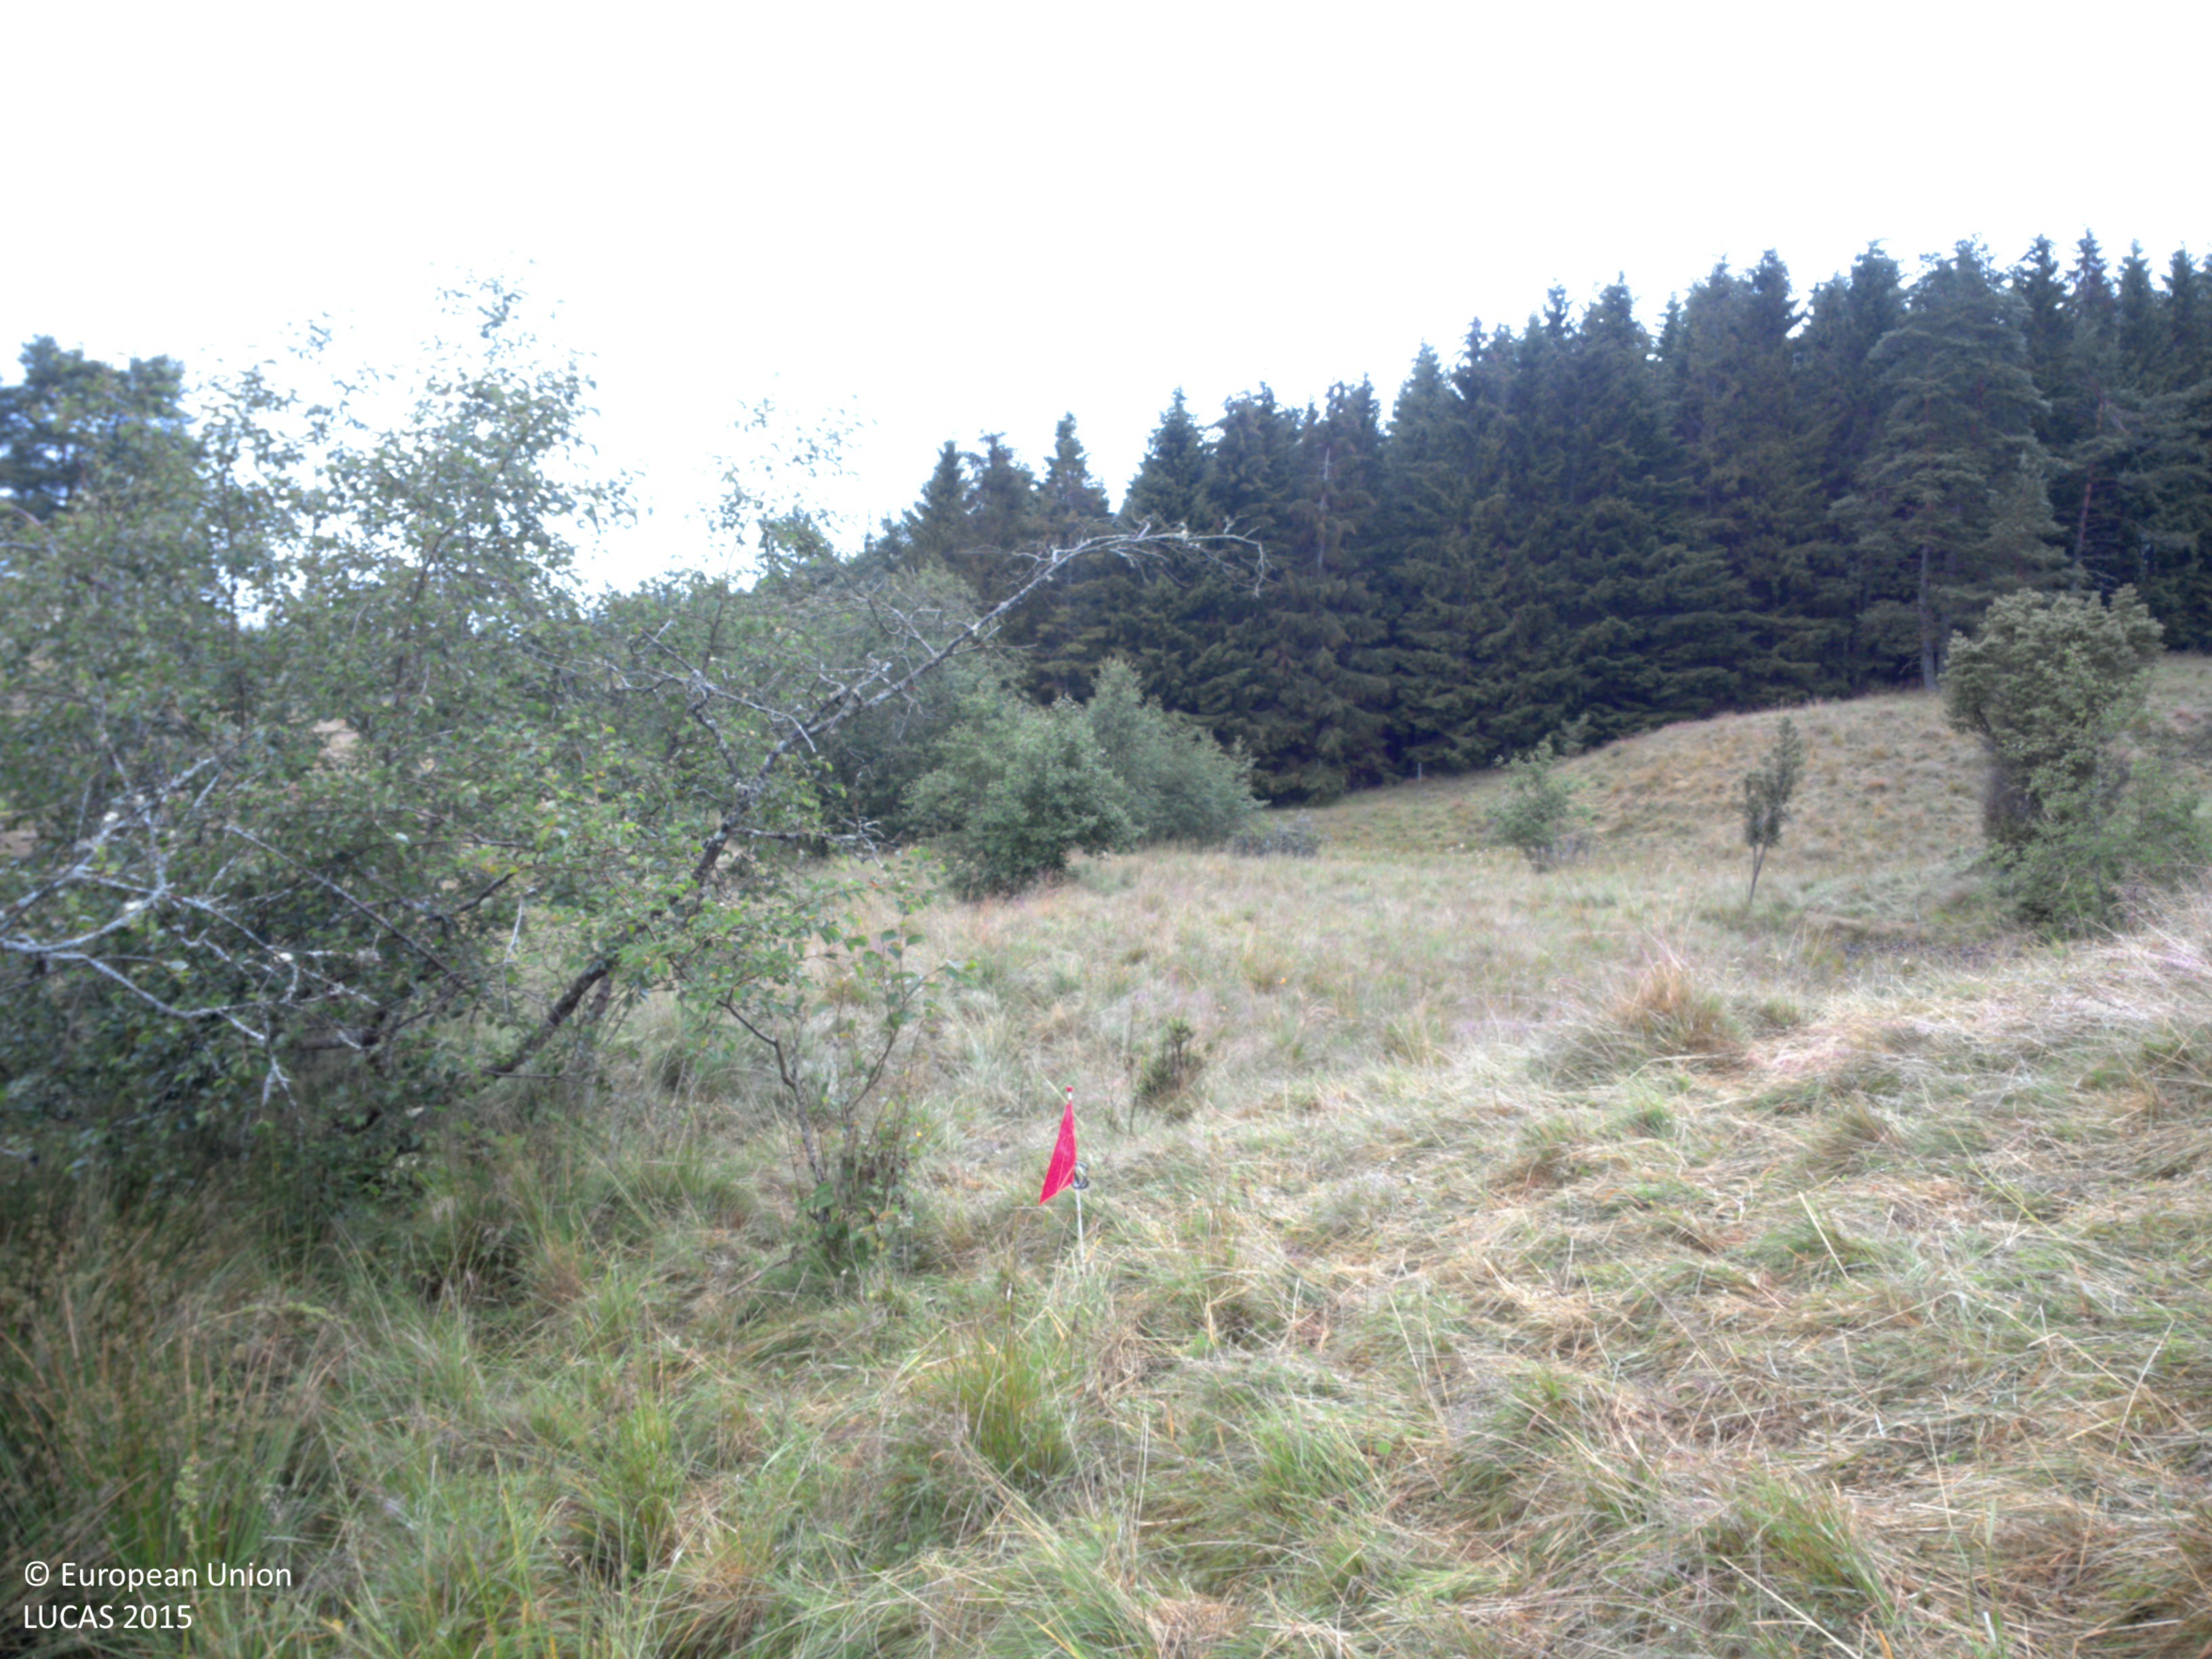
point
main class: Grassland
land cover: Grassland with sparse tree/shrub cover
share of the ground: > 75 %
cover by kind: herbaceous plants 95 %, coniferous forest trees 5 %
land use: Agriculture (excluding fallow land and kitchen gardens)
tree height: < 5 m
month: July
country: SE
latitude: 58.7291
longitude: 11.8095
